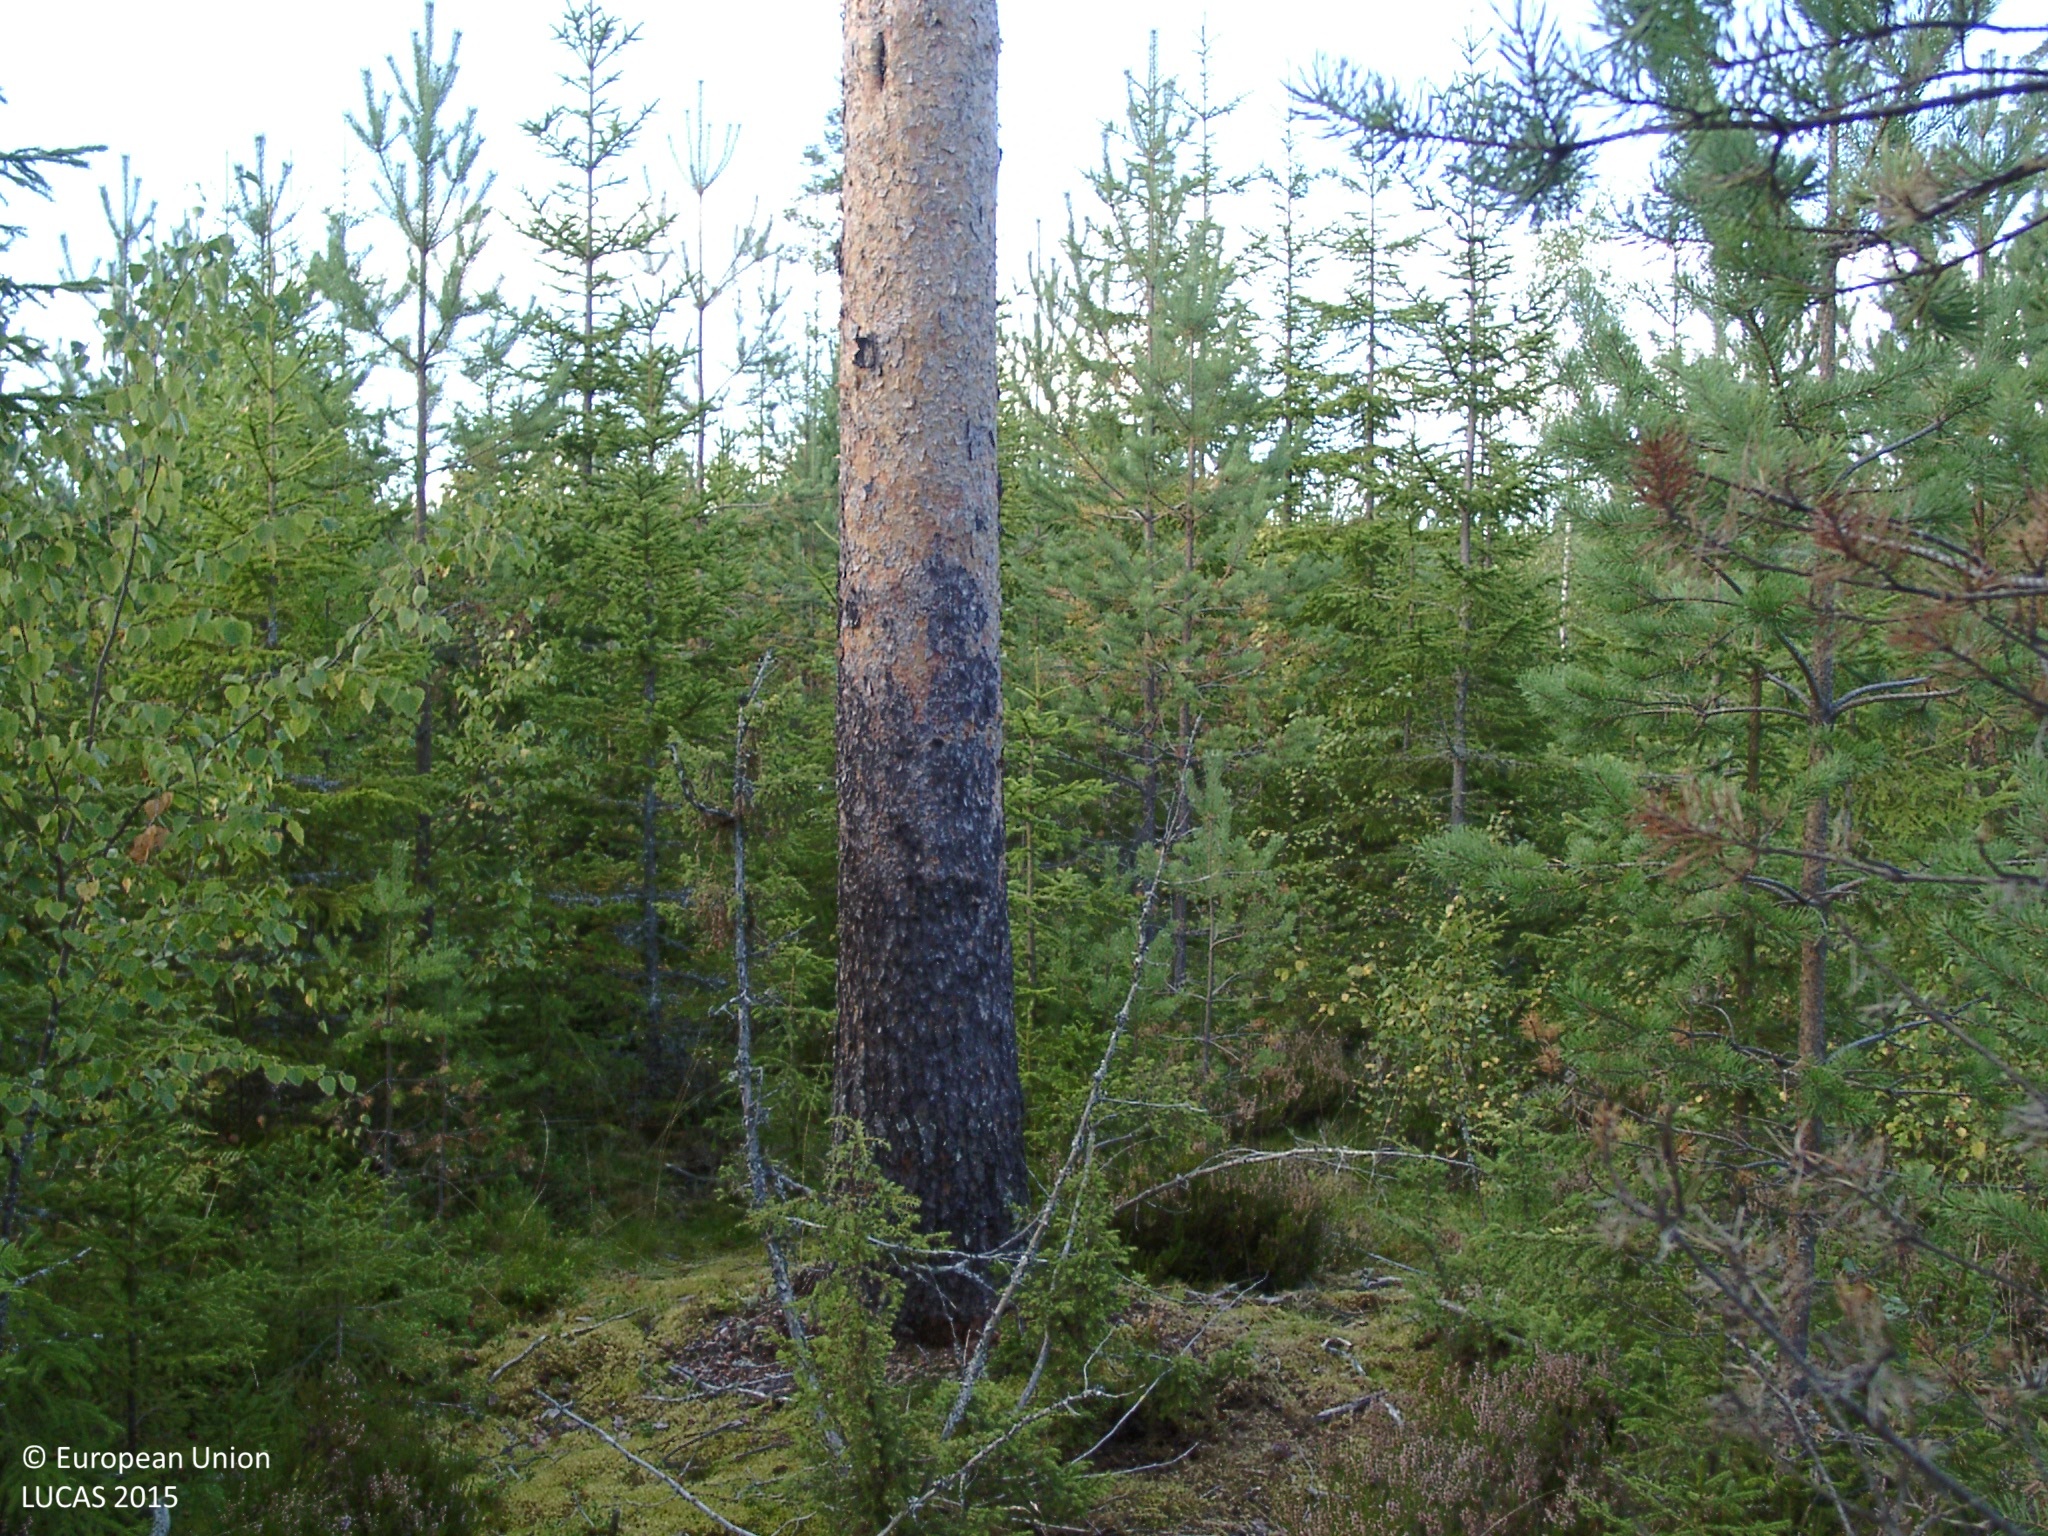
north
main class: Woodland
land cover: Other coniferous woodland
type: boreal forest
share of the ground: 50 - 75 %
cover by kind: coniferous forest trees 50 %, shrubs 30 %, broadleaved forest trees 10 %, lichens and mosses 10 %
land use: Forestry
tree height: < 5 m
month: September
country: FI
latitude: 62.6818
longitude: 25.2008
